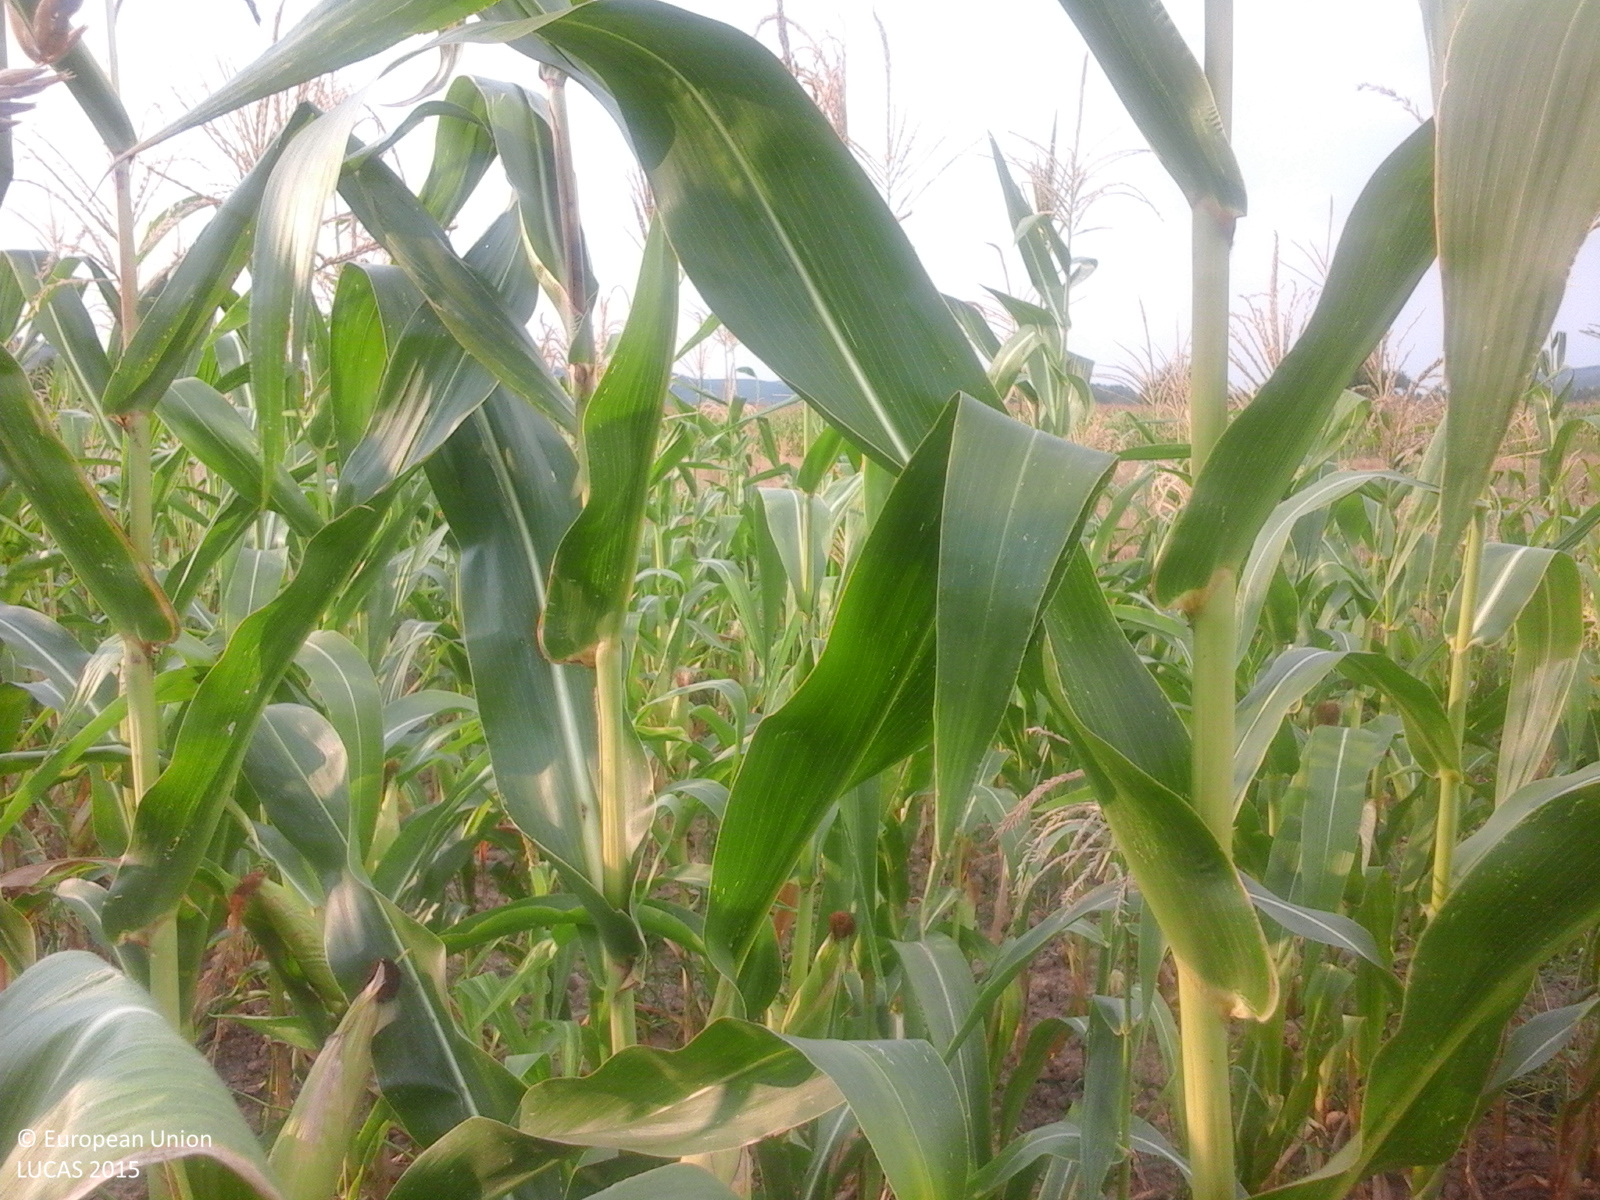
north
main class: Cropland
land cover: Maize
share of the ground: > 75 %
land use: Agriculture (excluding fallow land and kitchen gardens)
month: August
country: RO
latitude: 44.7606
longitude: 23.6386
